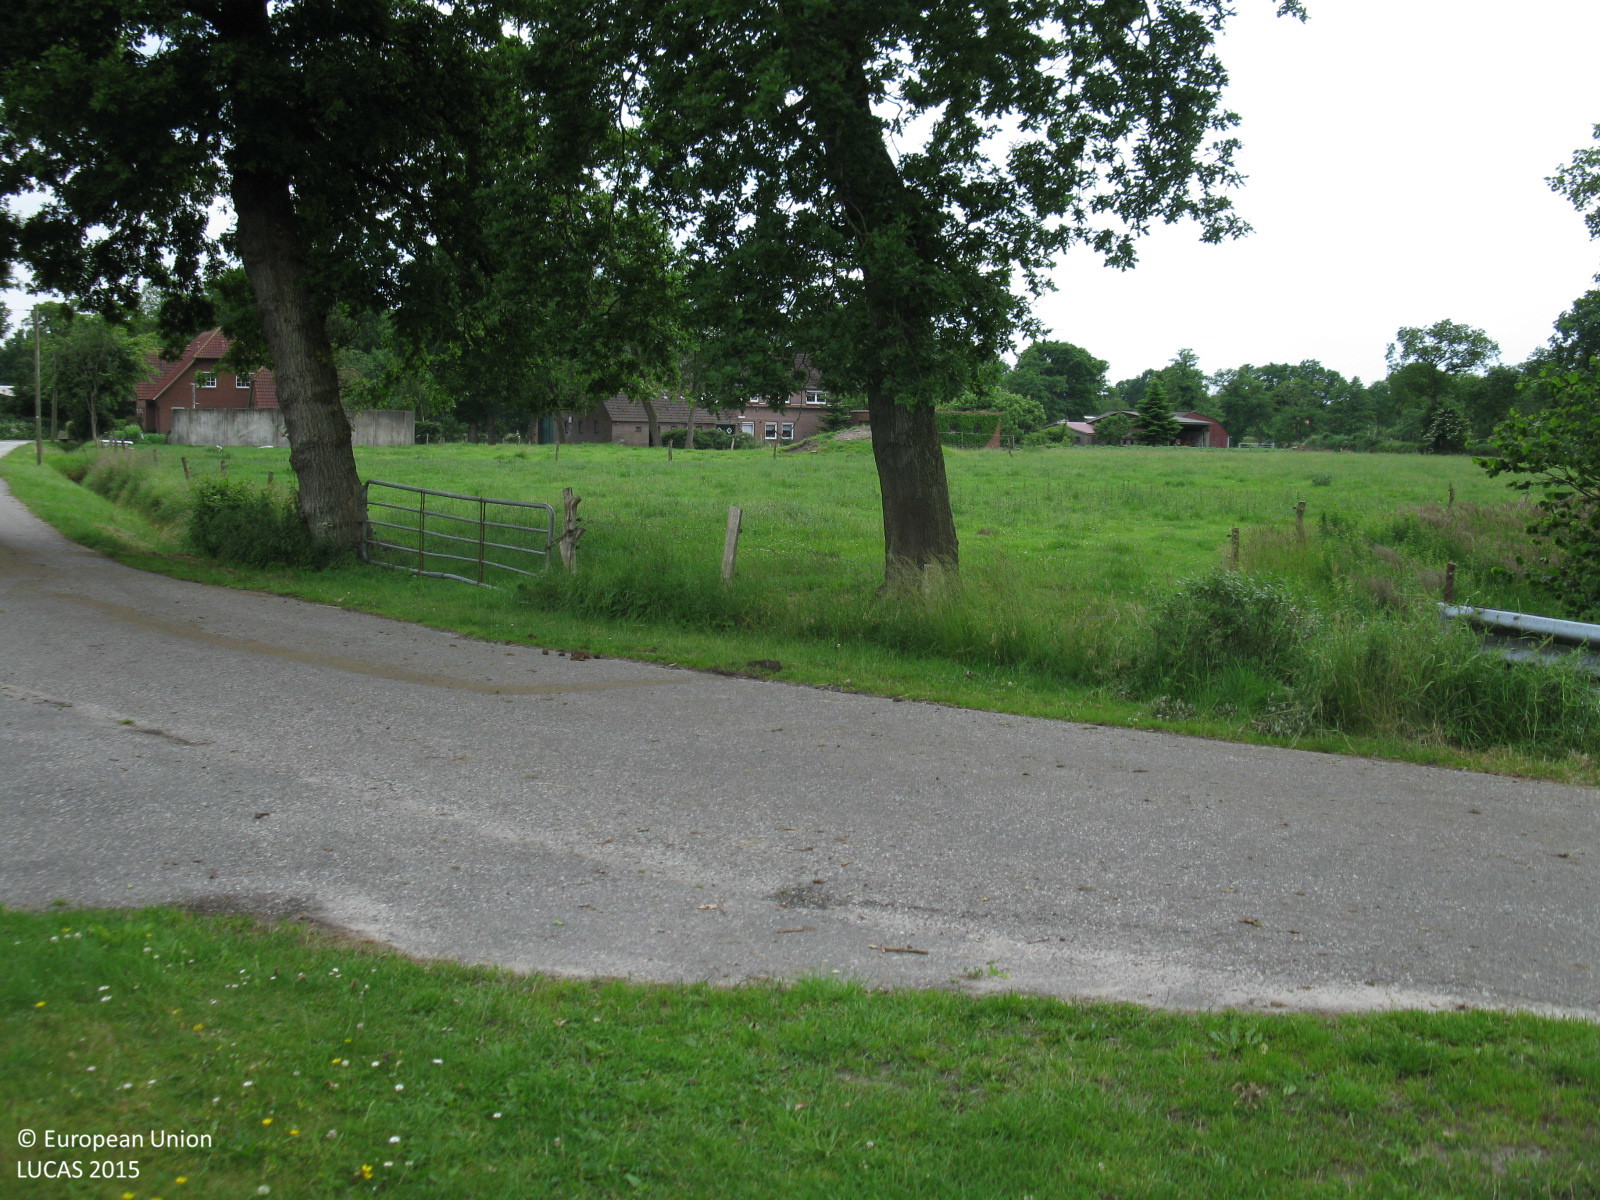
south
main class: Grassland
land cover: Grassland without tree/shrub cover
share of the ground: > 75 %
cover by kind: herbaceous plants 100 %
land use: Agriculture (excluding fallow land and kitchen gardens)
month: June
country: DE
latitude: 53.5091
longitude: 7.8746
